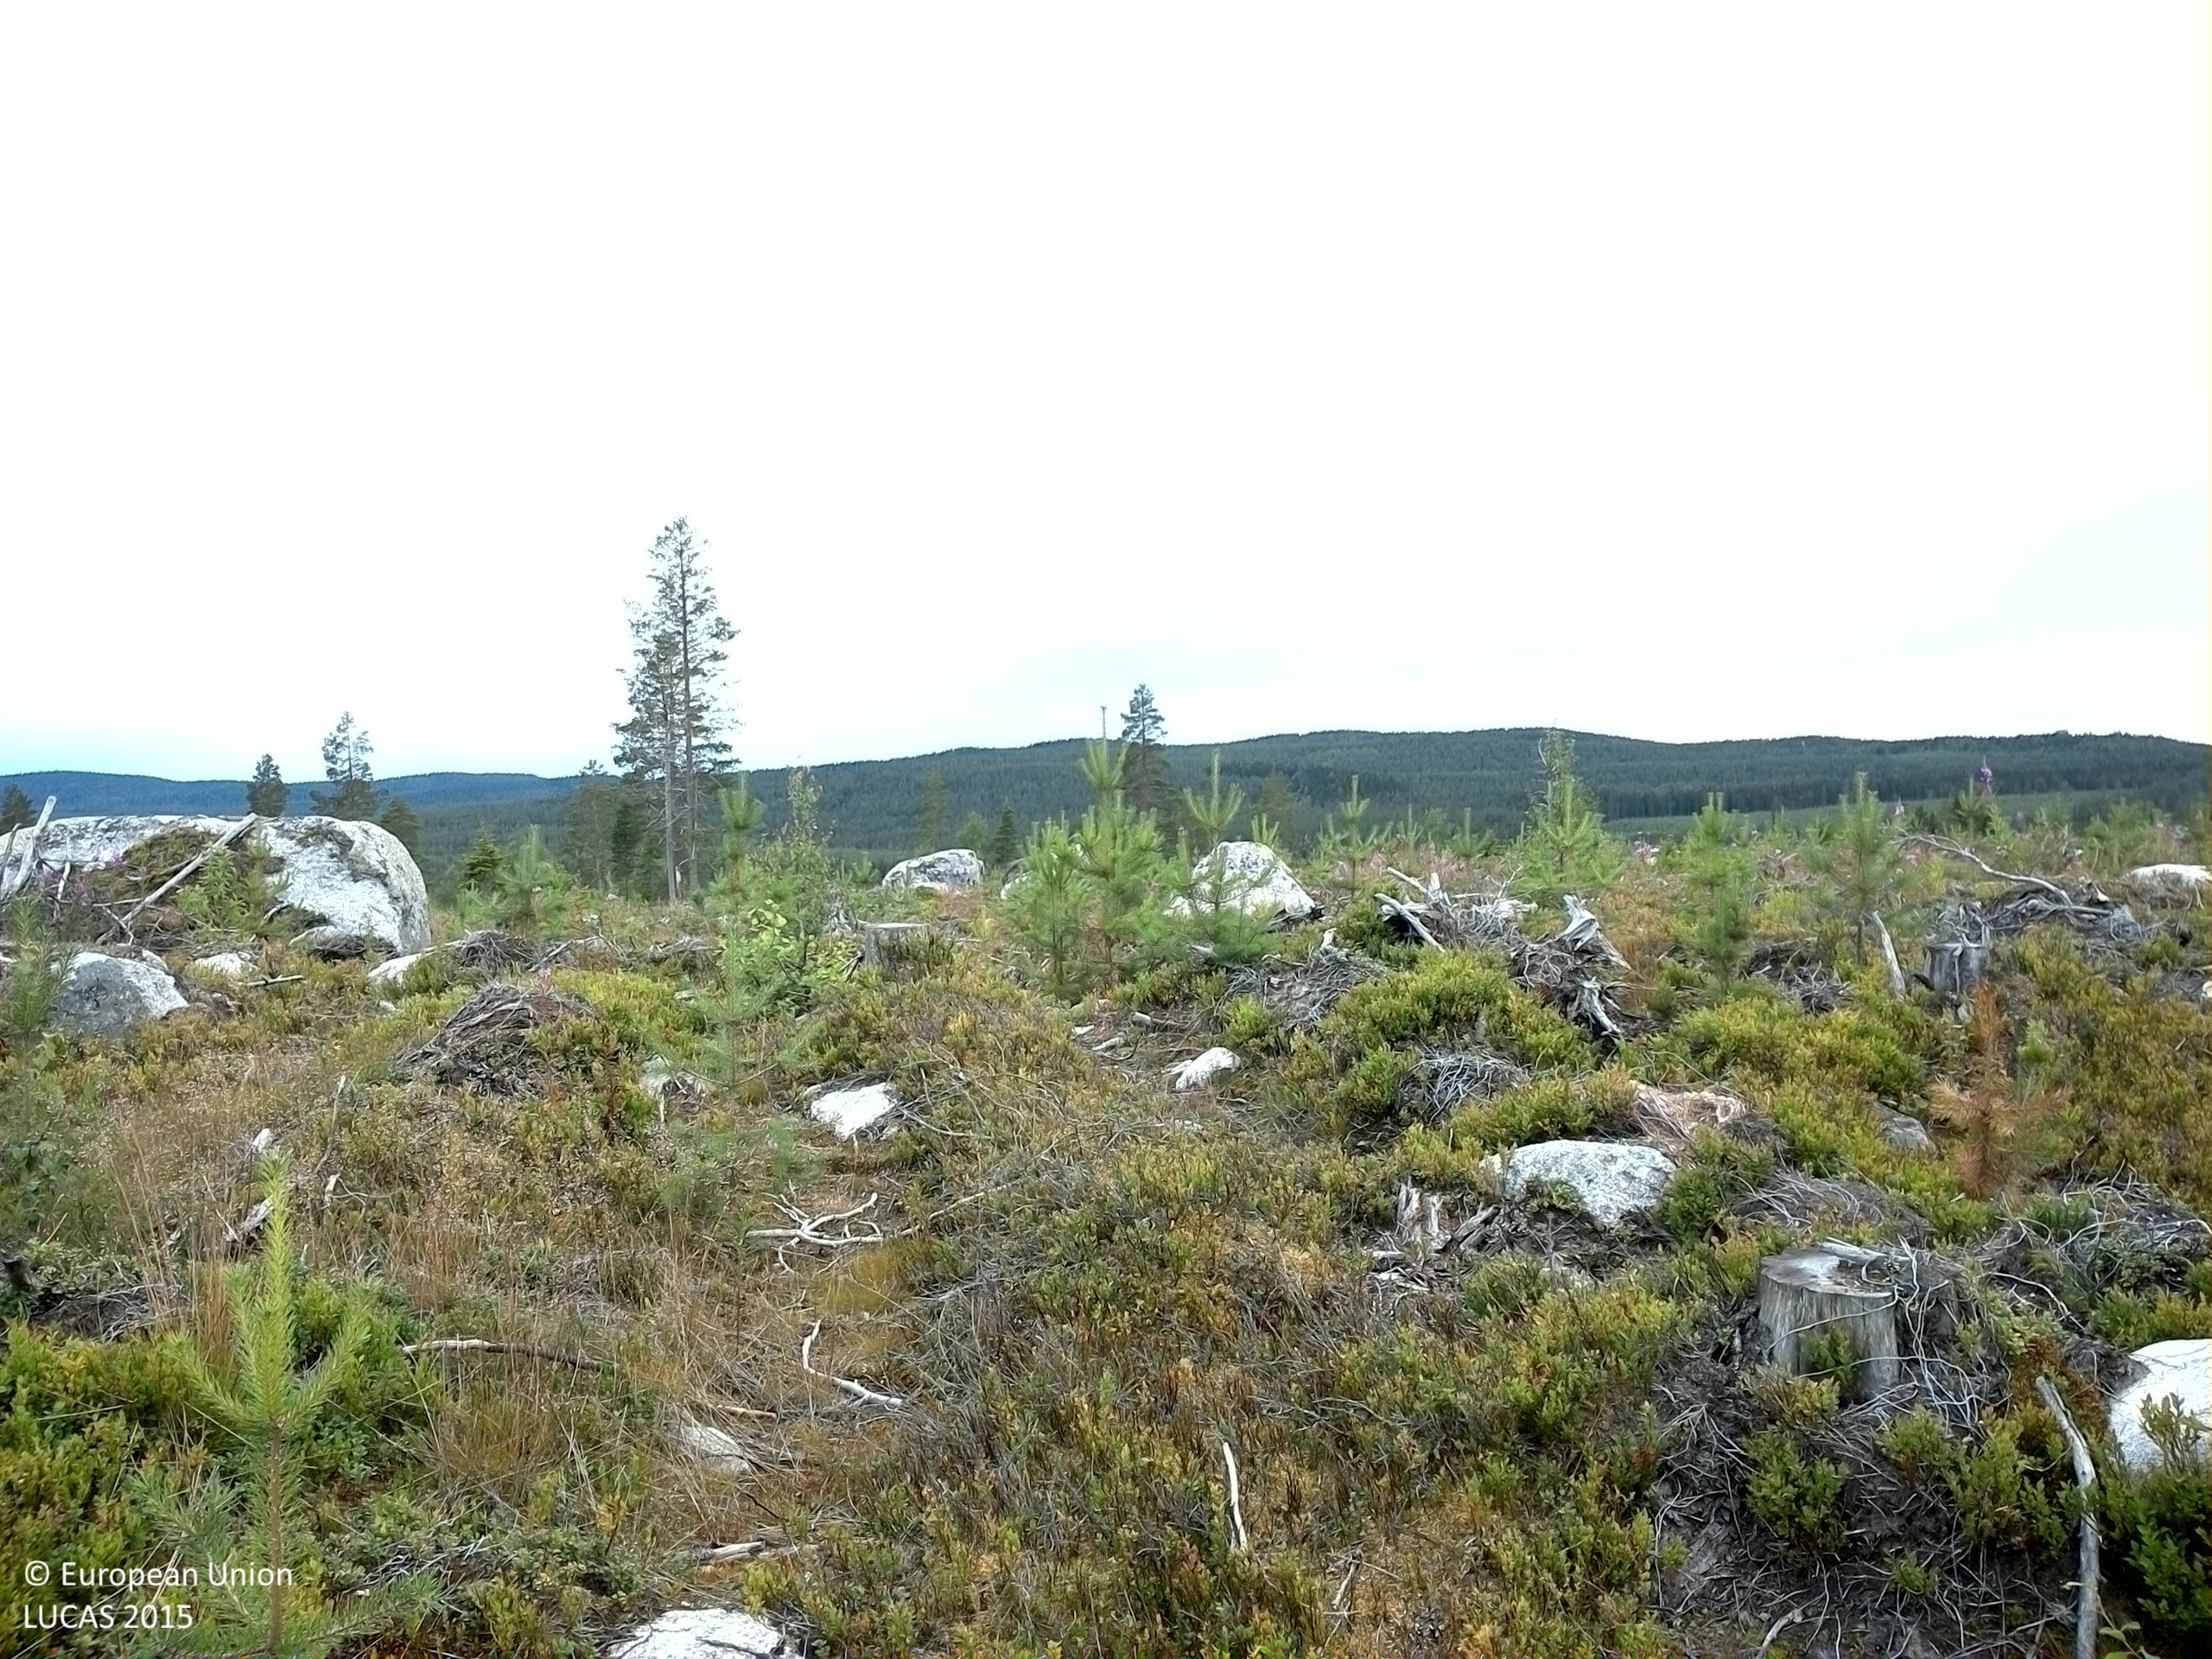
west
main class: Woodland
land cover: Pine dominated mixed woodland
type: boreal forest
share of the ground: 10 - 25 %
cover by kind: shrubs 40 %, lichens and mosses 25 %, coniferous forest trees 10 %, herbaceous plants 10 %, unconsolidated bare surface 10 %, broadleaved forest trees 5 %
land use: Forestry
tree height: < 5 m
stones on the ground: 25 - 50 %
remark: Clear cut
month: August
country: SE
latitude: 63.7489
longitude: 18.2210
